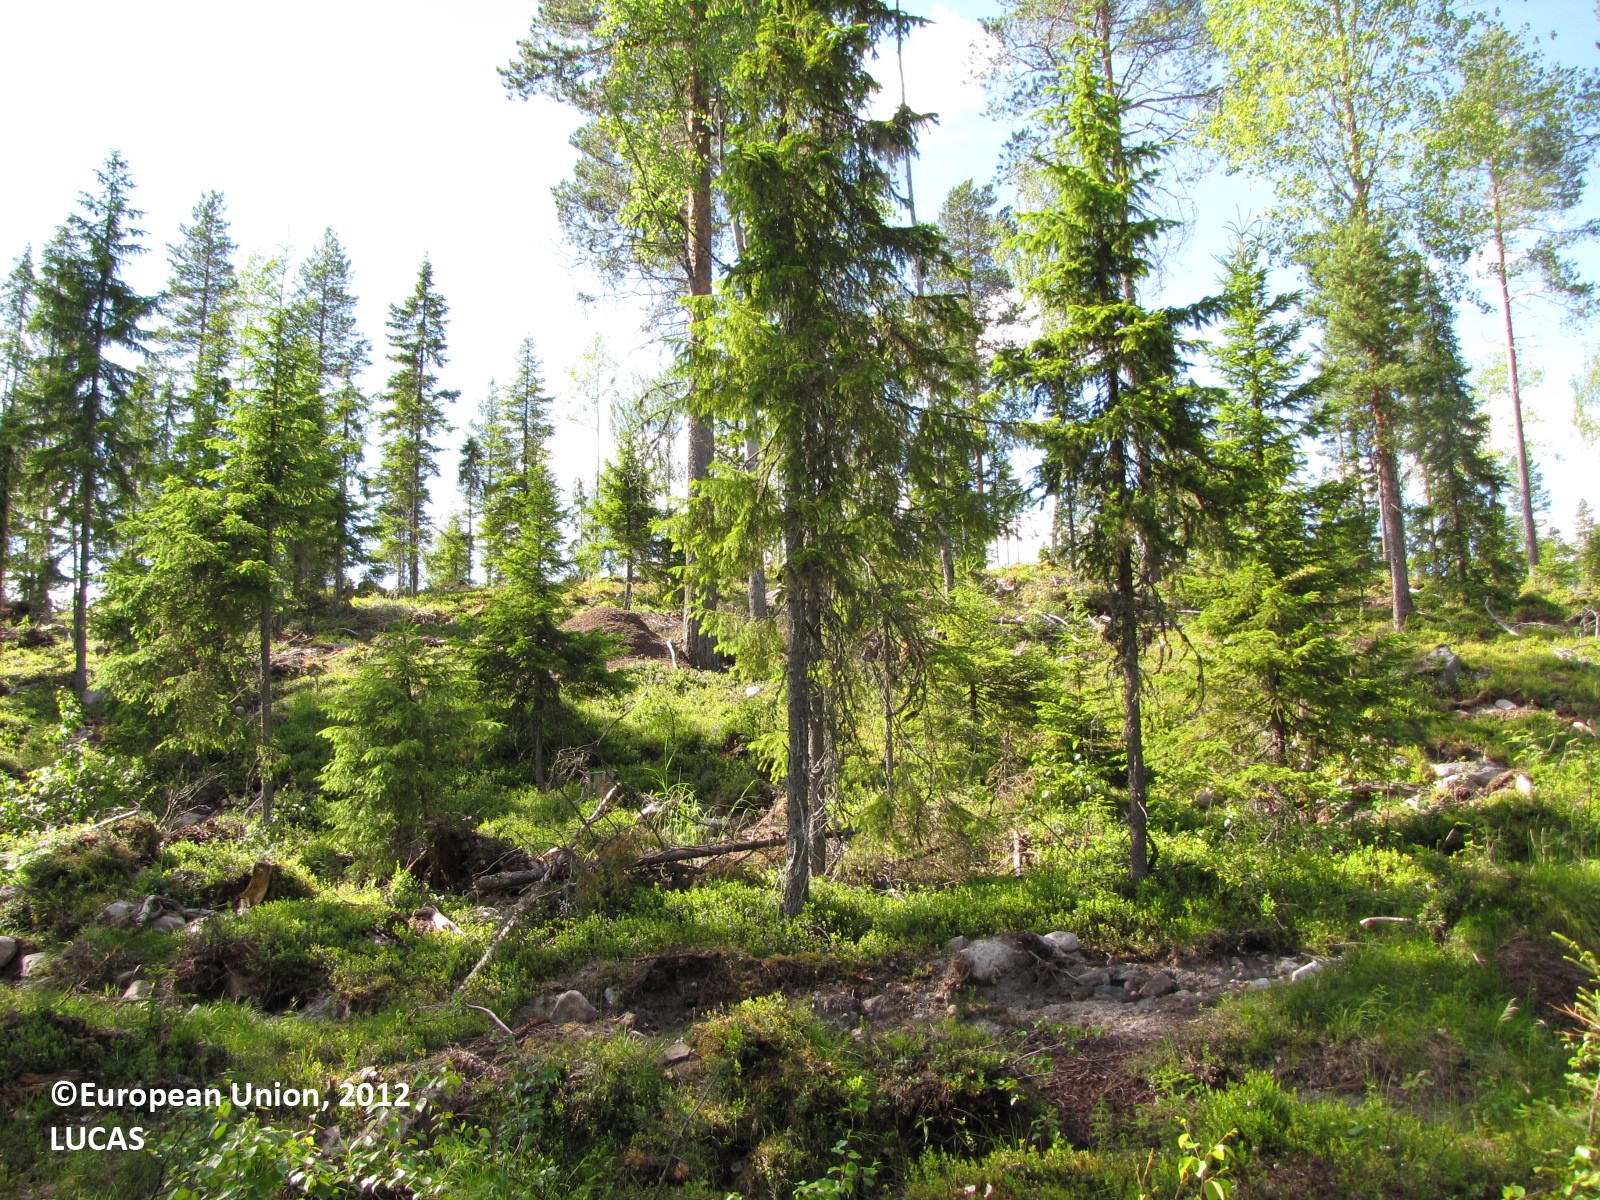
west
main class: Woodland
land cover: Spruce dominated mixed woodland
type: boreal forest
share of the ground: 25 - 50 %
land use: Forestry
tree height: > 5 m
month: July
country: FI
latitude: 66.2435
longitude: 25.2561
